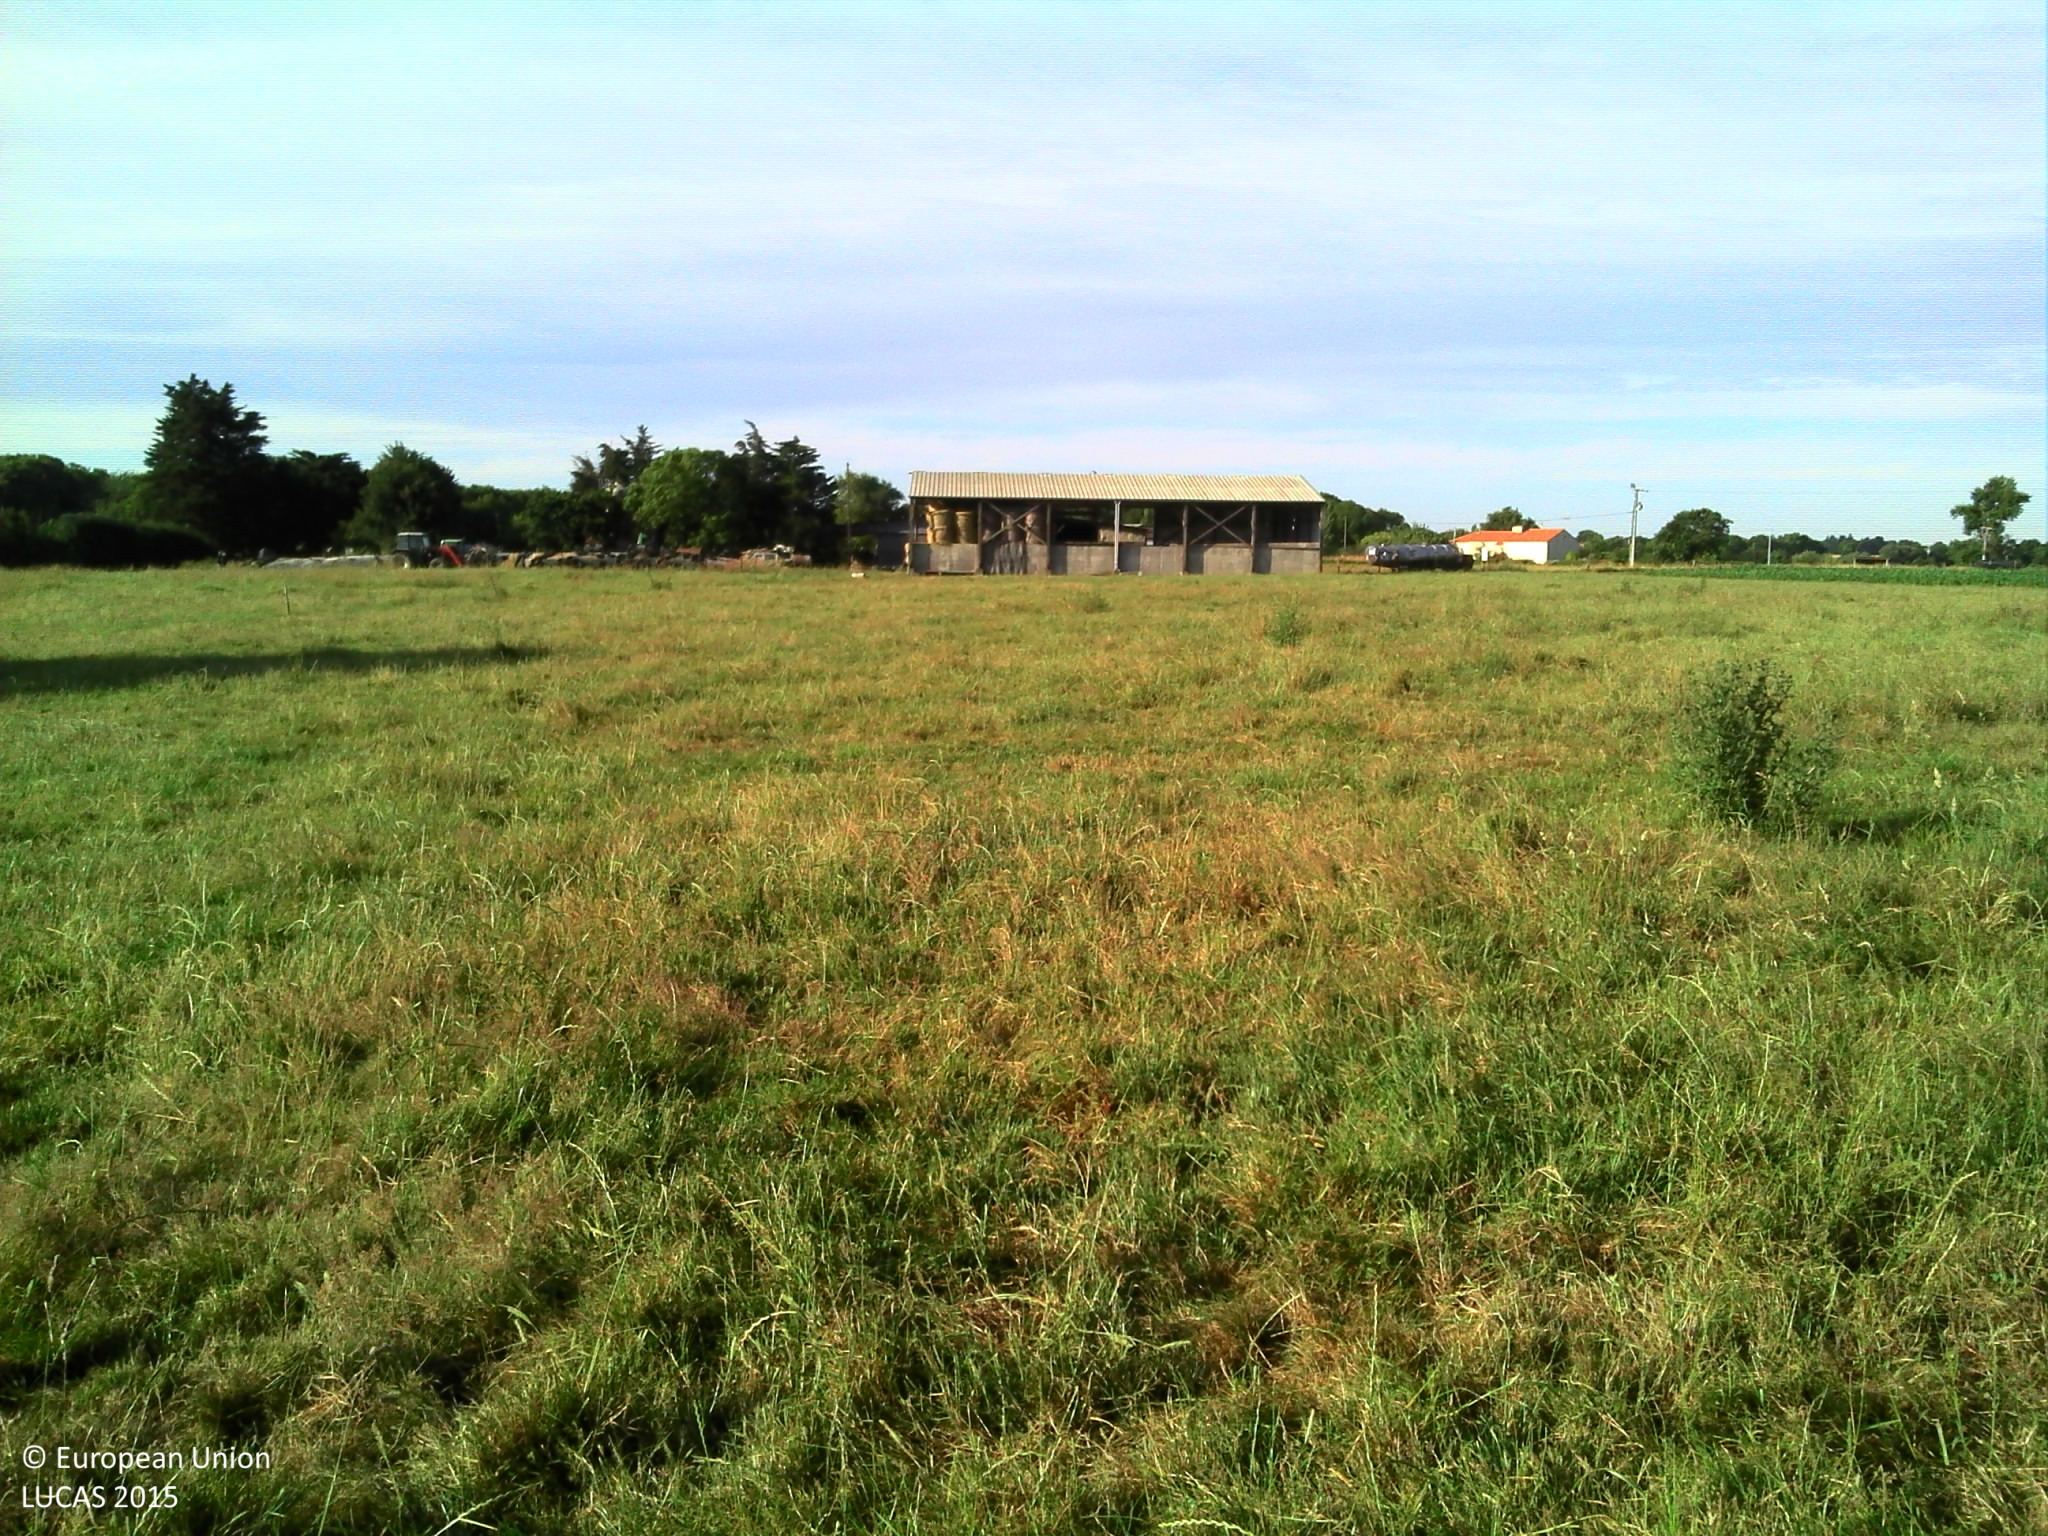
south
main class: Cropland
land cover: Temporary grasslands
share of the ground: > 75 %
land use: Agriculture (excluding fallow land and kitchen gardens)
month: June
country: FR
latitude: 47.2642
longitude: -2.0897
